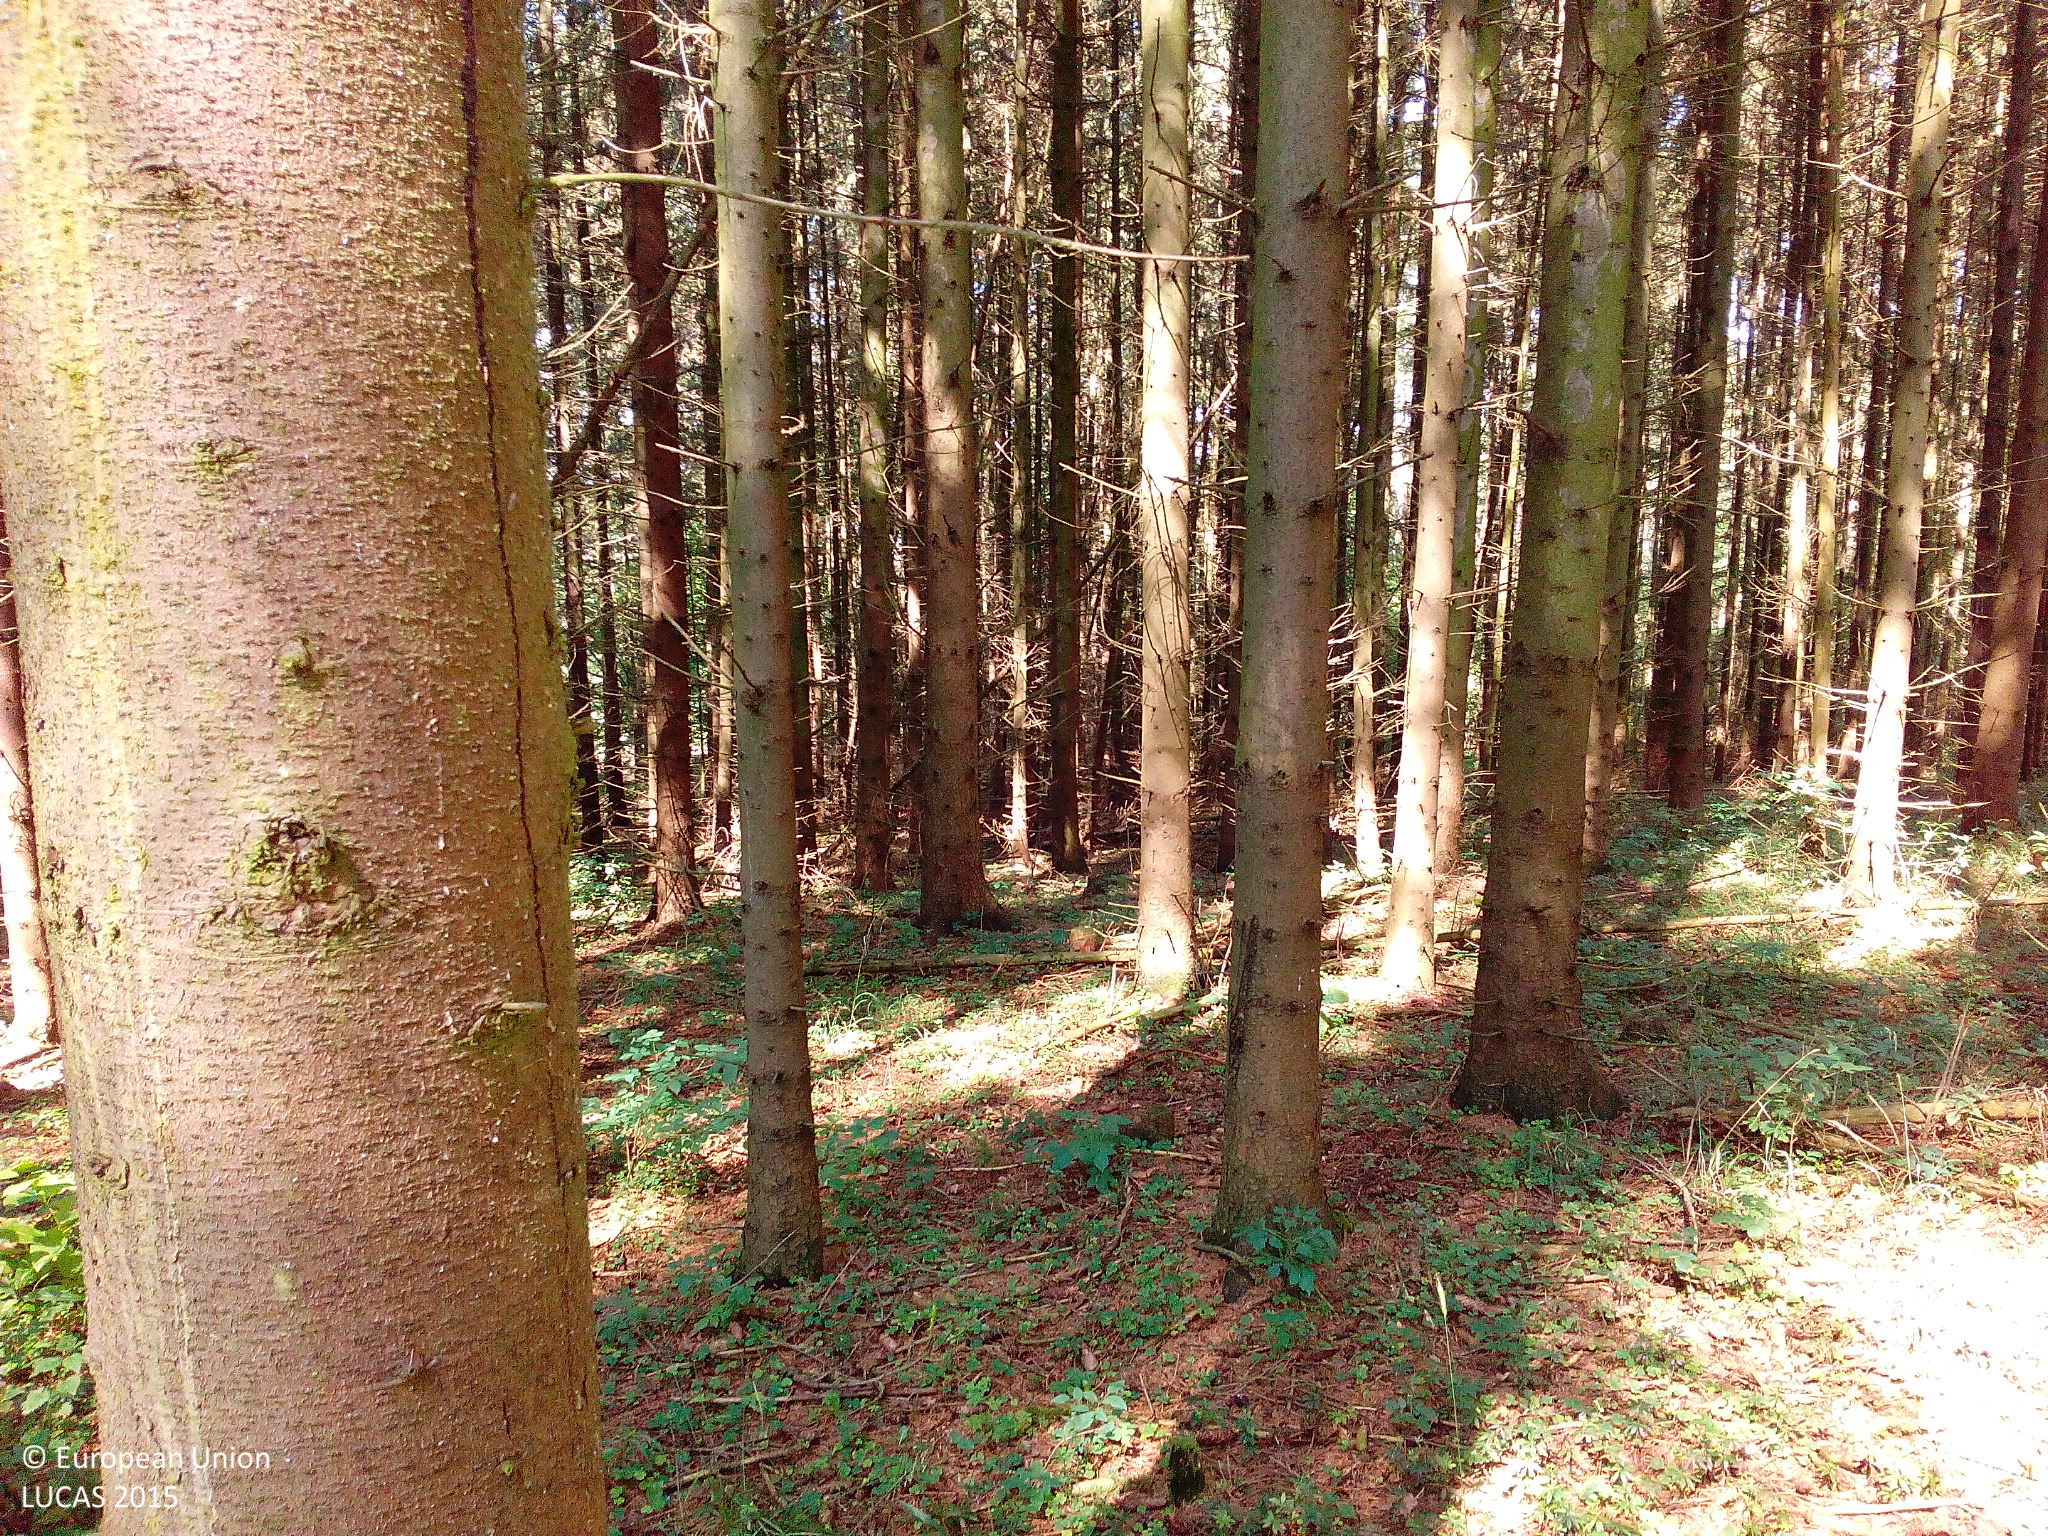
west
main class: Woodland
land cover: Spruce dominated coniferous woodland
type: hemiboreal forest and nemoral coniferous forest and mixed broadleaved-coniferous forest
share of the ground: > 75 %
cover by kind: coniferous forest trees 90 %, broadleaved forest trees 5 %, herbaceous plants 5 %
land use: Forestry
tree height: > 5 m
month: July
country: DE
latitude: 50.6517
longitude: 9.9576
